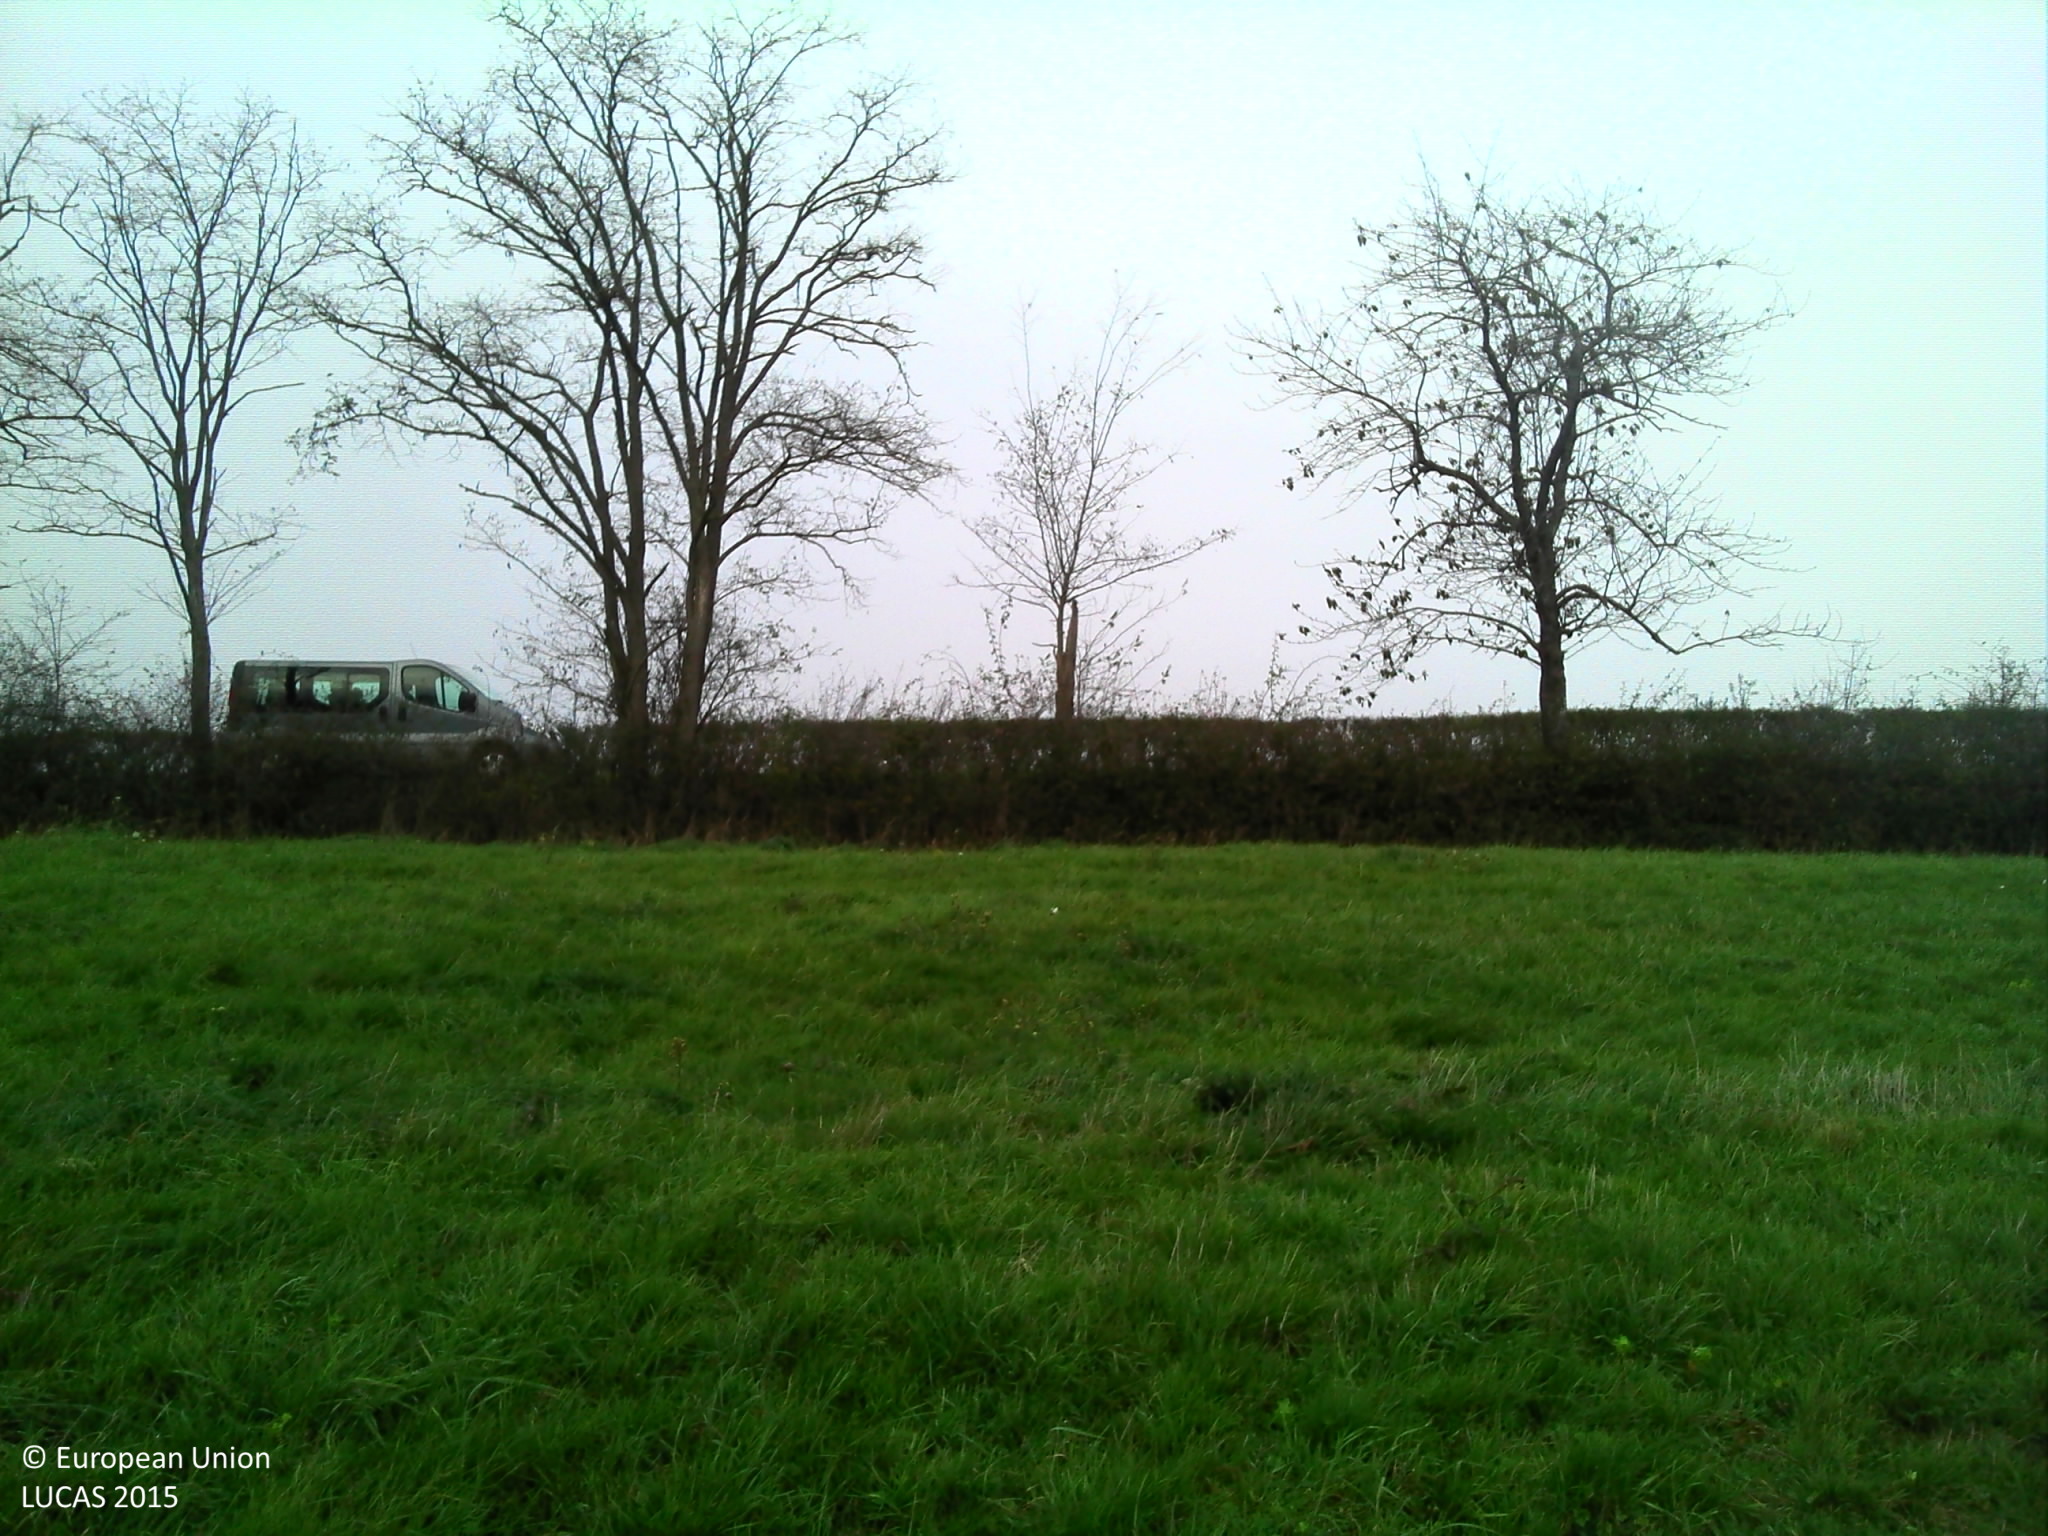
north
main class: Grassland
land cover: Grassland without tree/shrub cover
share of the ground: > 75 %
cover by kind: herbaceous plants 100 %
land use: Agriculture (excluding fallow land and kitchen gardens)
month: November
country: FR
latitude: 46.3639
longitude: 3.6958
